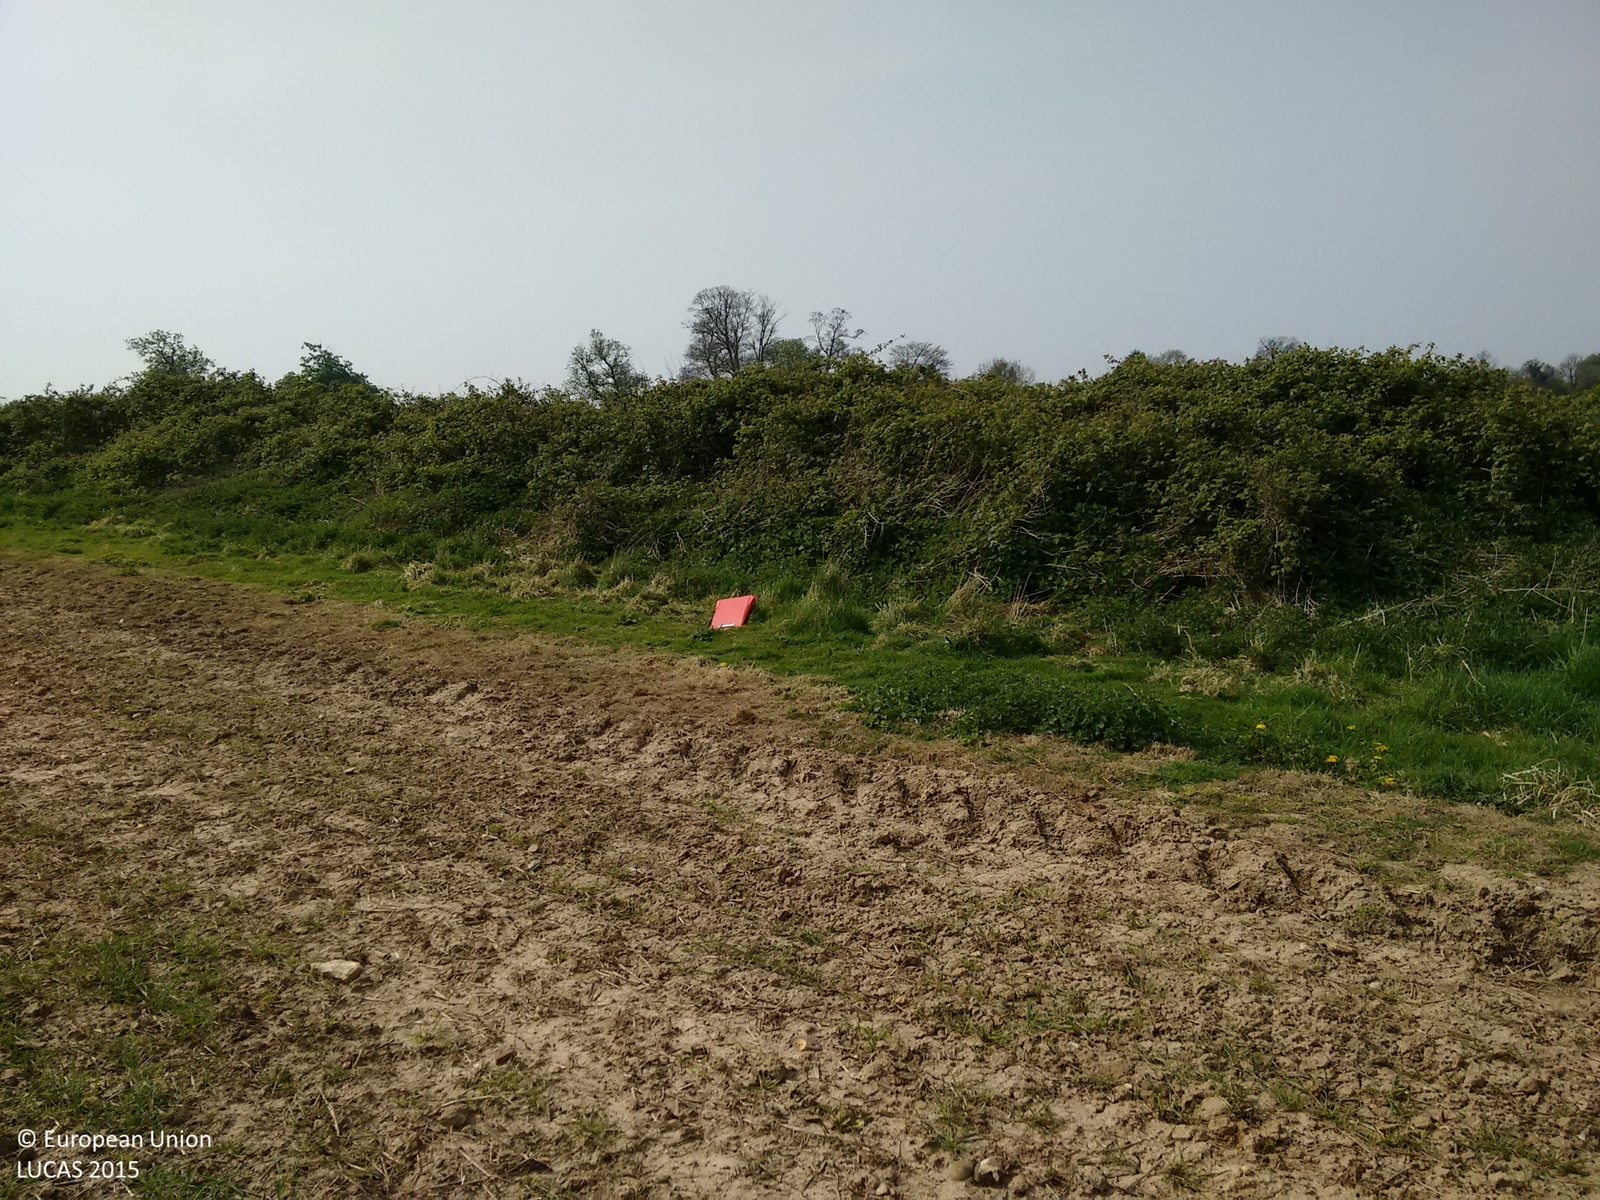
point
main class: Cropland
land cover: Common wheat
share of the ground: 25 - 50 %
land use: Agriculture (excluding fallow land and kitchen gardens)
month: April
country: GB
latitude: 51.3912
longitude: 0.4144
